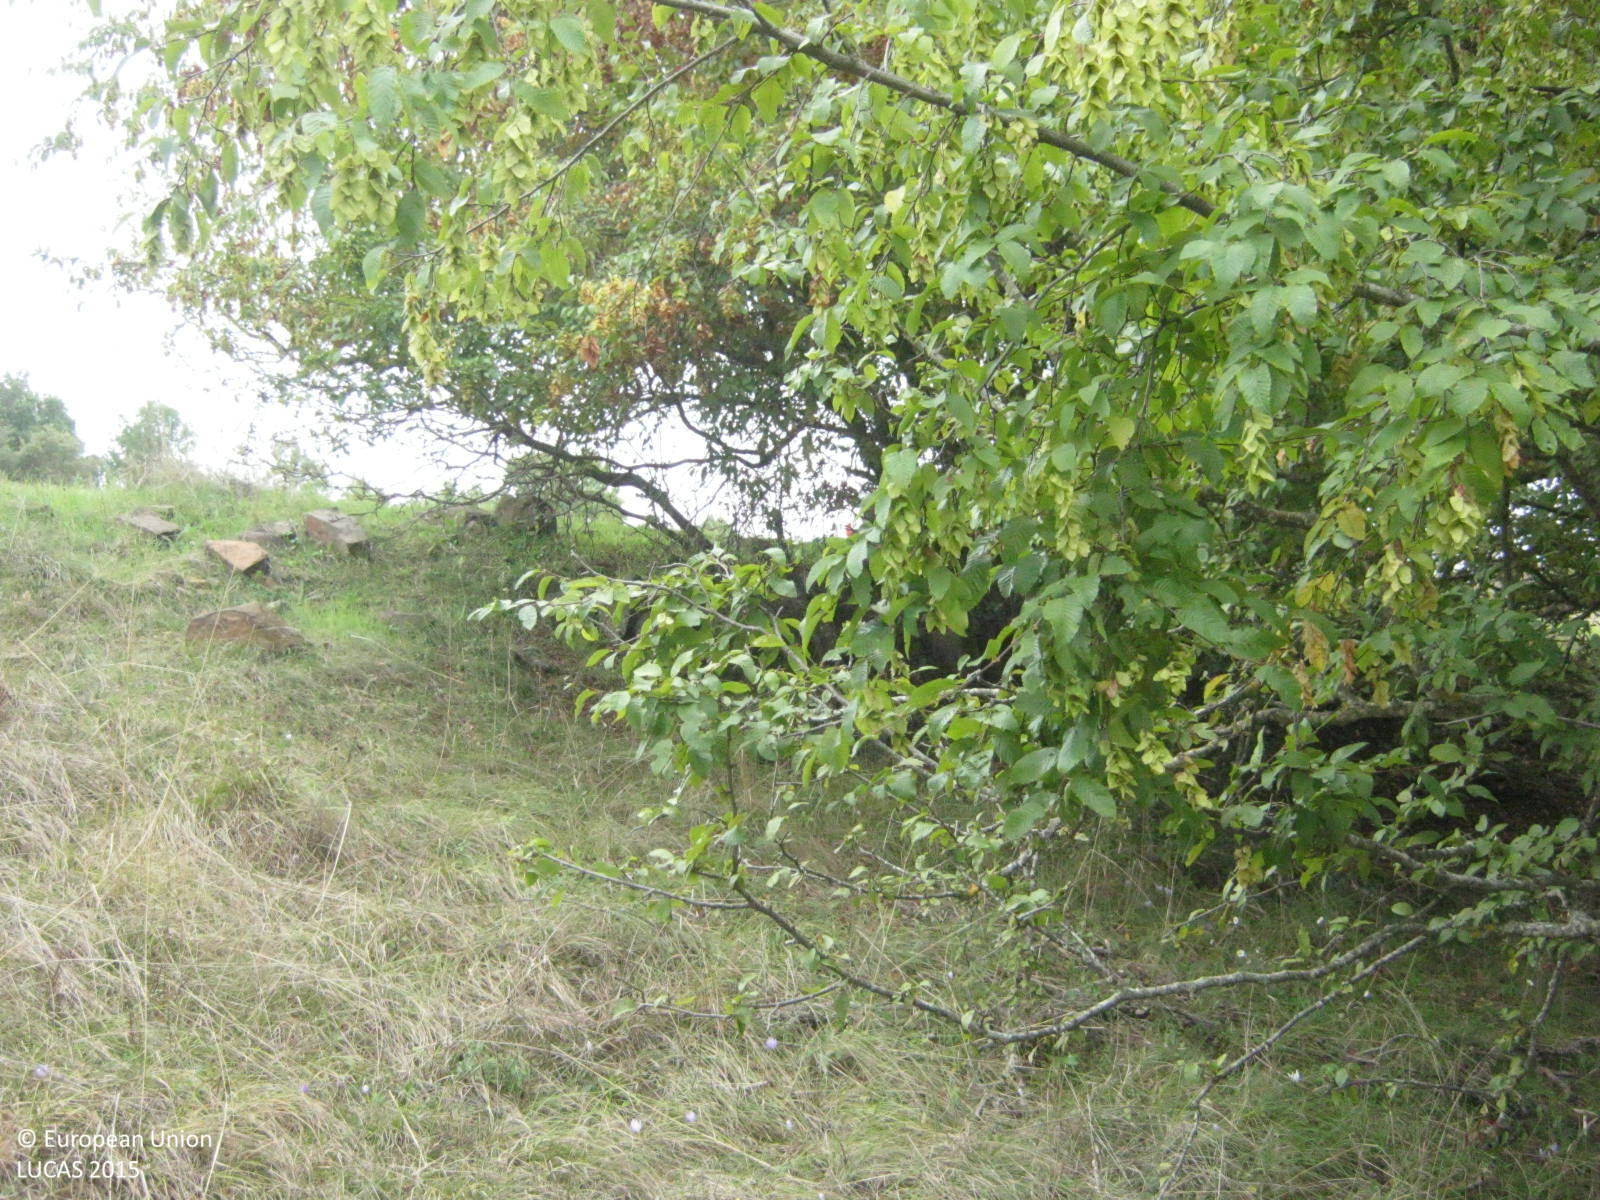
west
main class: Grassland
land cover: Spontaneously vegetated surfaces
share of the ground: > 75 %
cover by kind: herbaceous plants 90 %, unconsolidated bare surface 10 %
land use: Fallow land
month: October
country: GR
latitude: 41.0960
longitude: 23.0264
